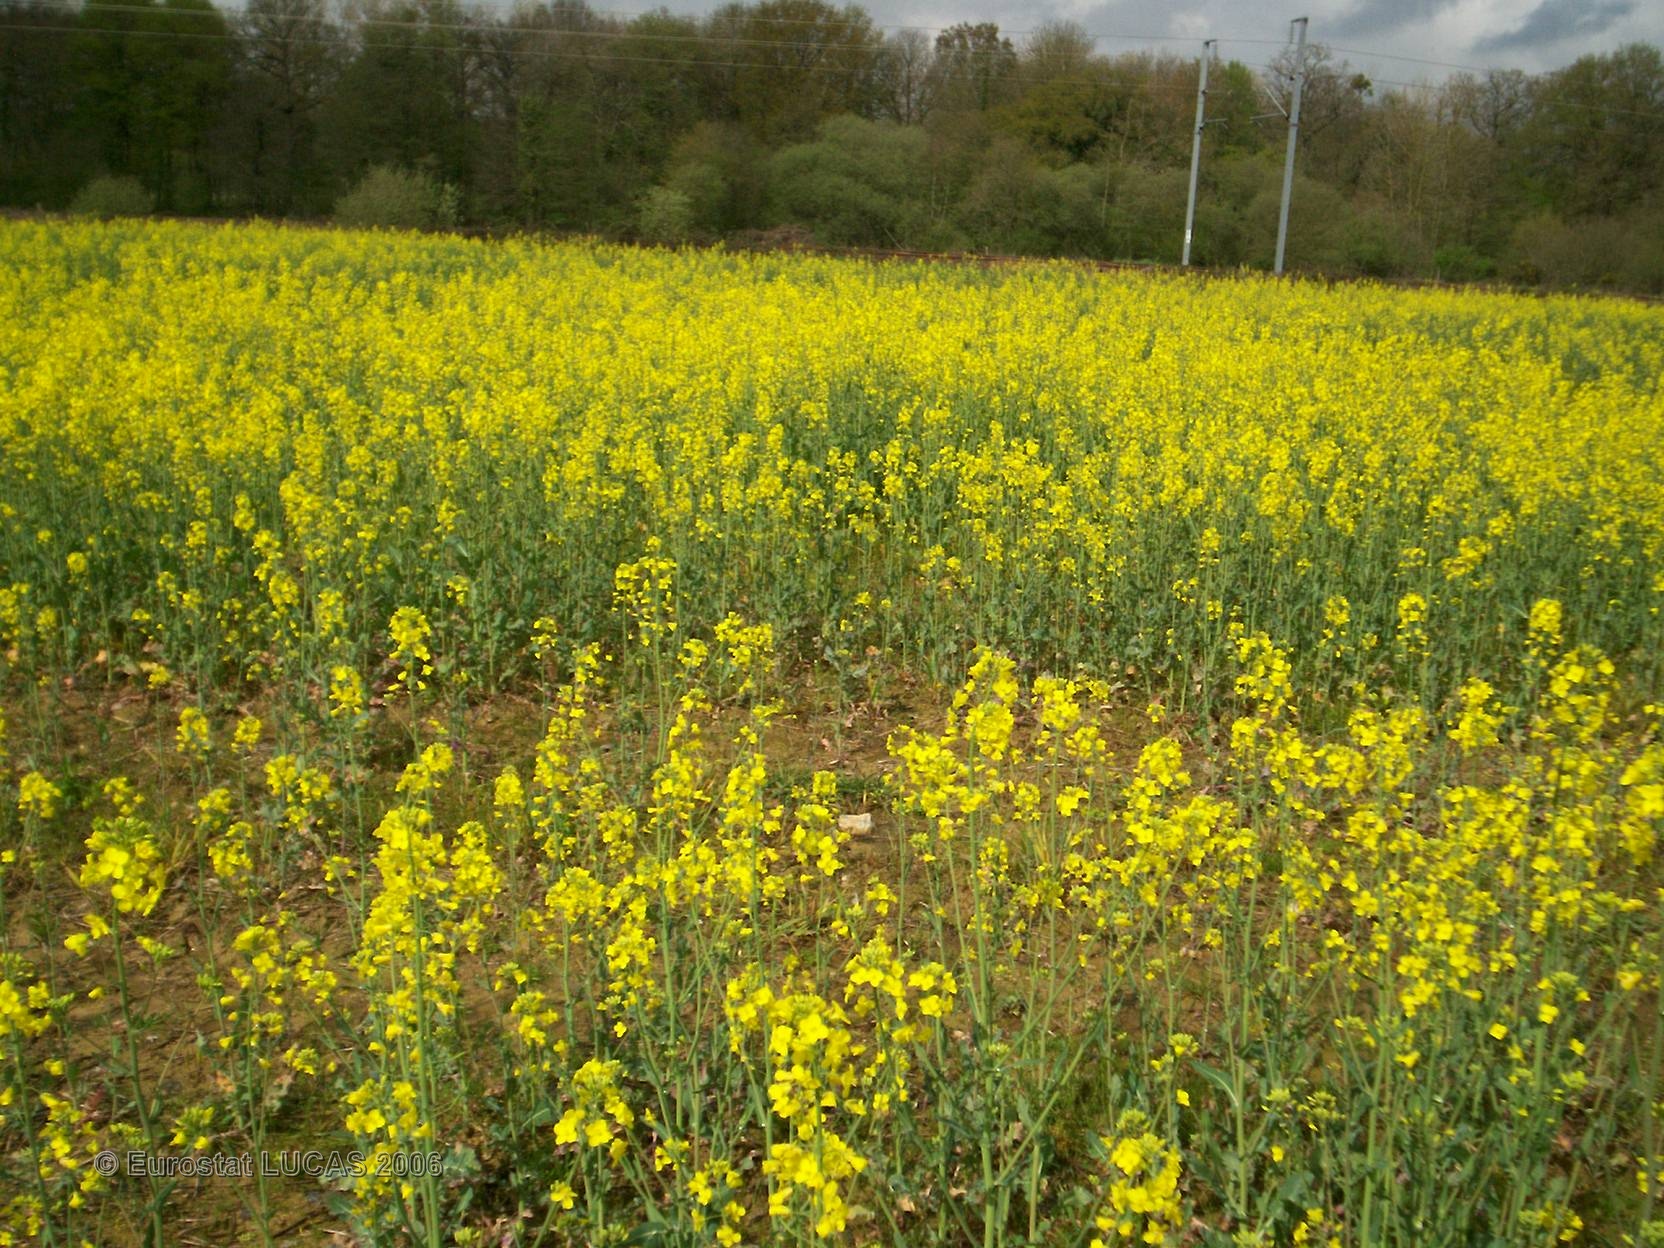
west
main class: Cropland
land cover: Rape and turnip rape
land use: Agriculture (excluding fallow land and kitchen gardens)
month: April
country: FR
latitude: 48.2229
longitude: -1.6374
